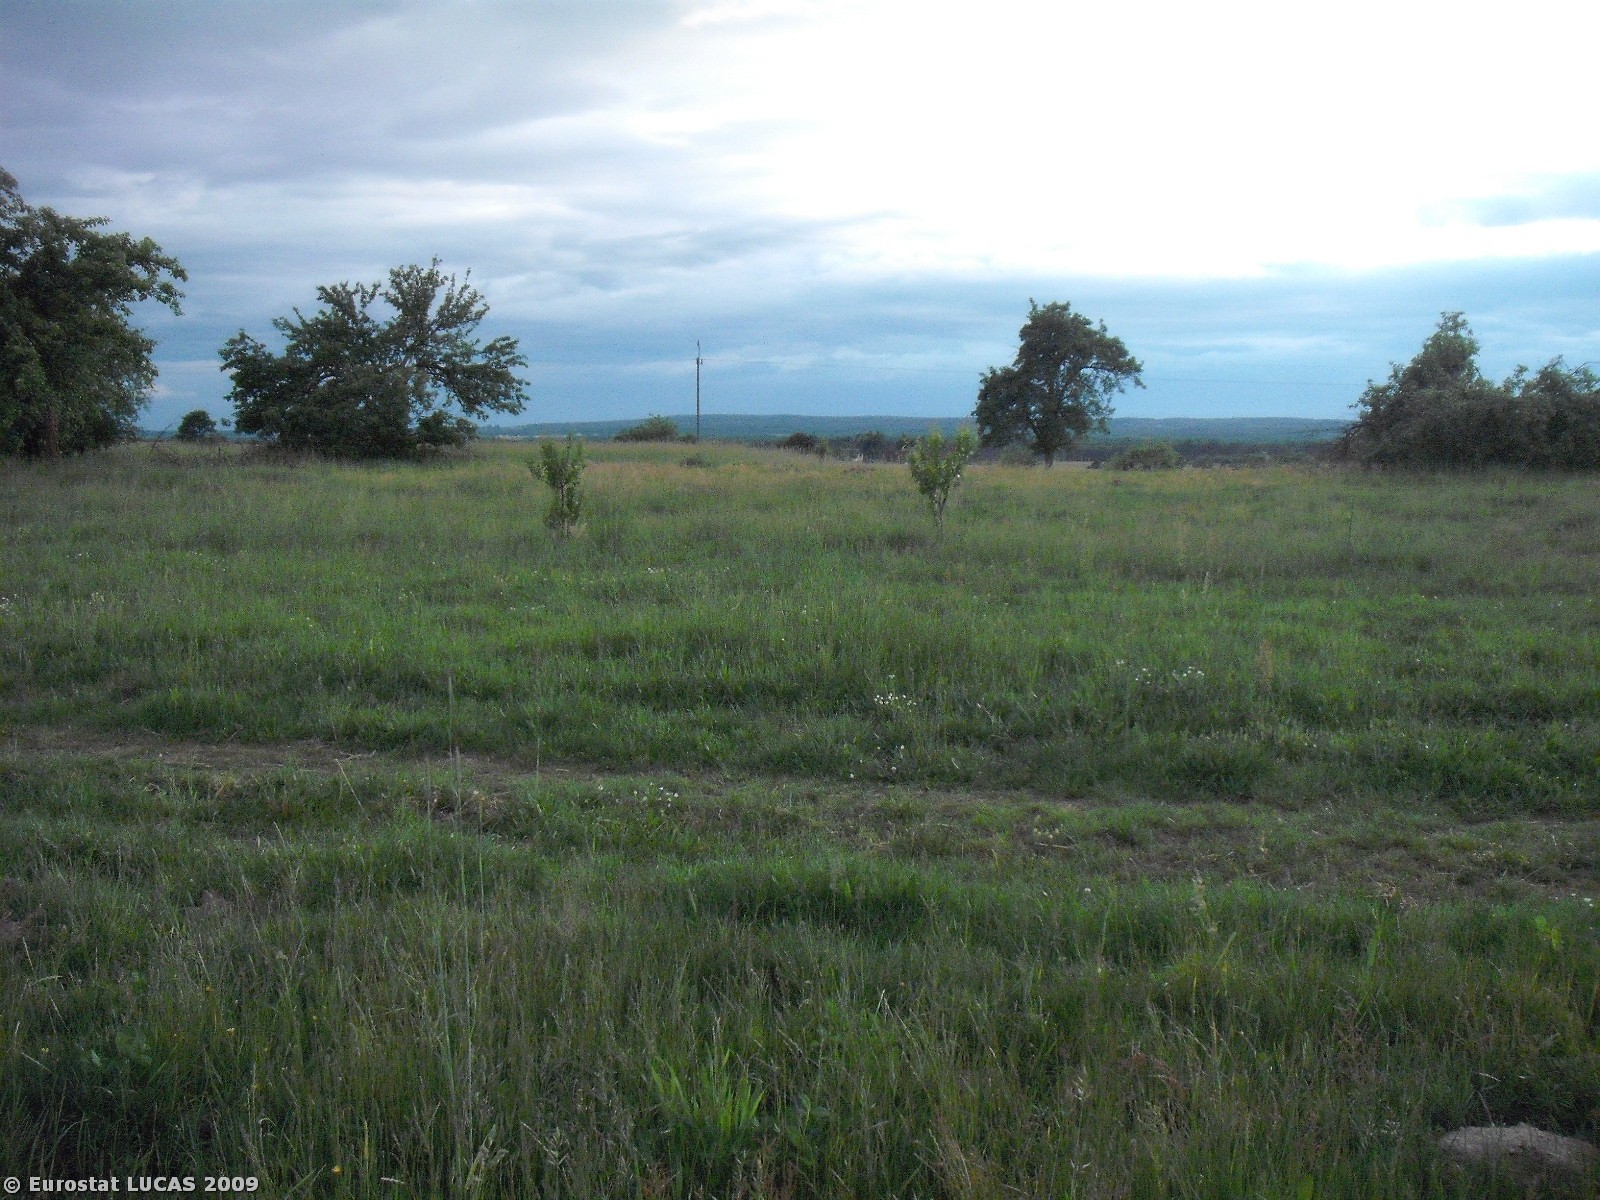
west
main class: Grassland
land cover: Grassland without tree/shrub cover
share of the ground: > 75 %
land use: Agriculture (excluding fallow land and kitchen gardens)
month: June
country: PL
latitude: 51.2153
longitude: 19.9535
